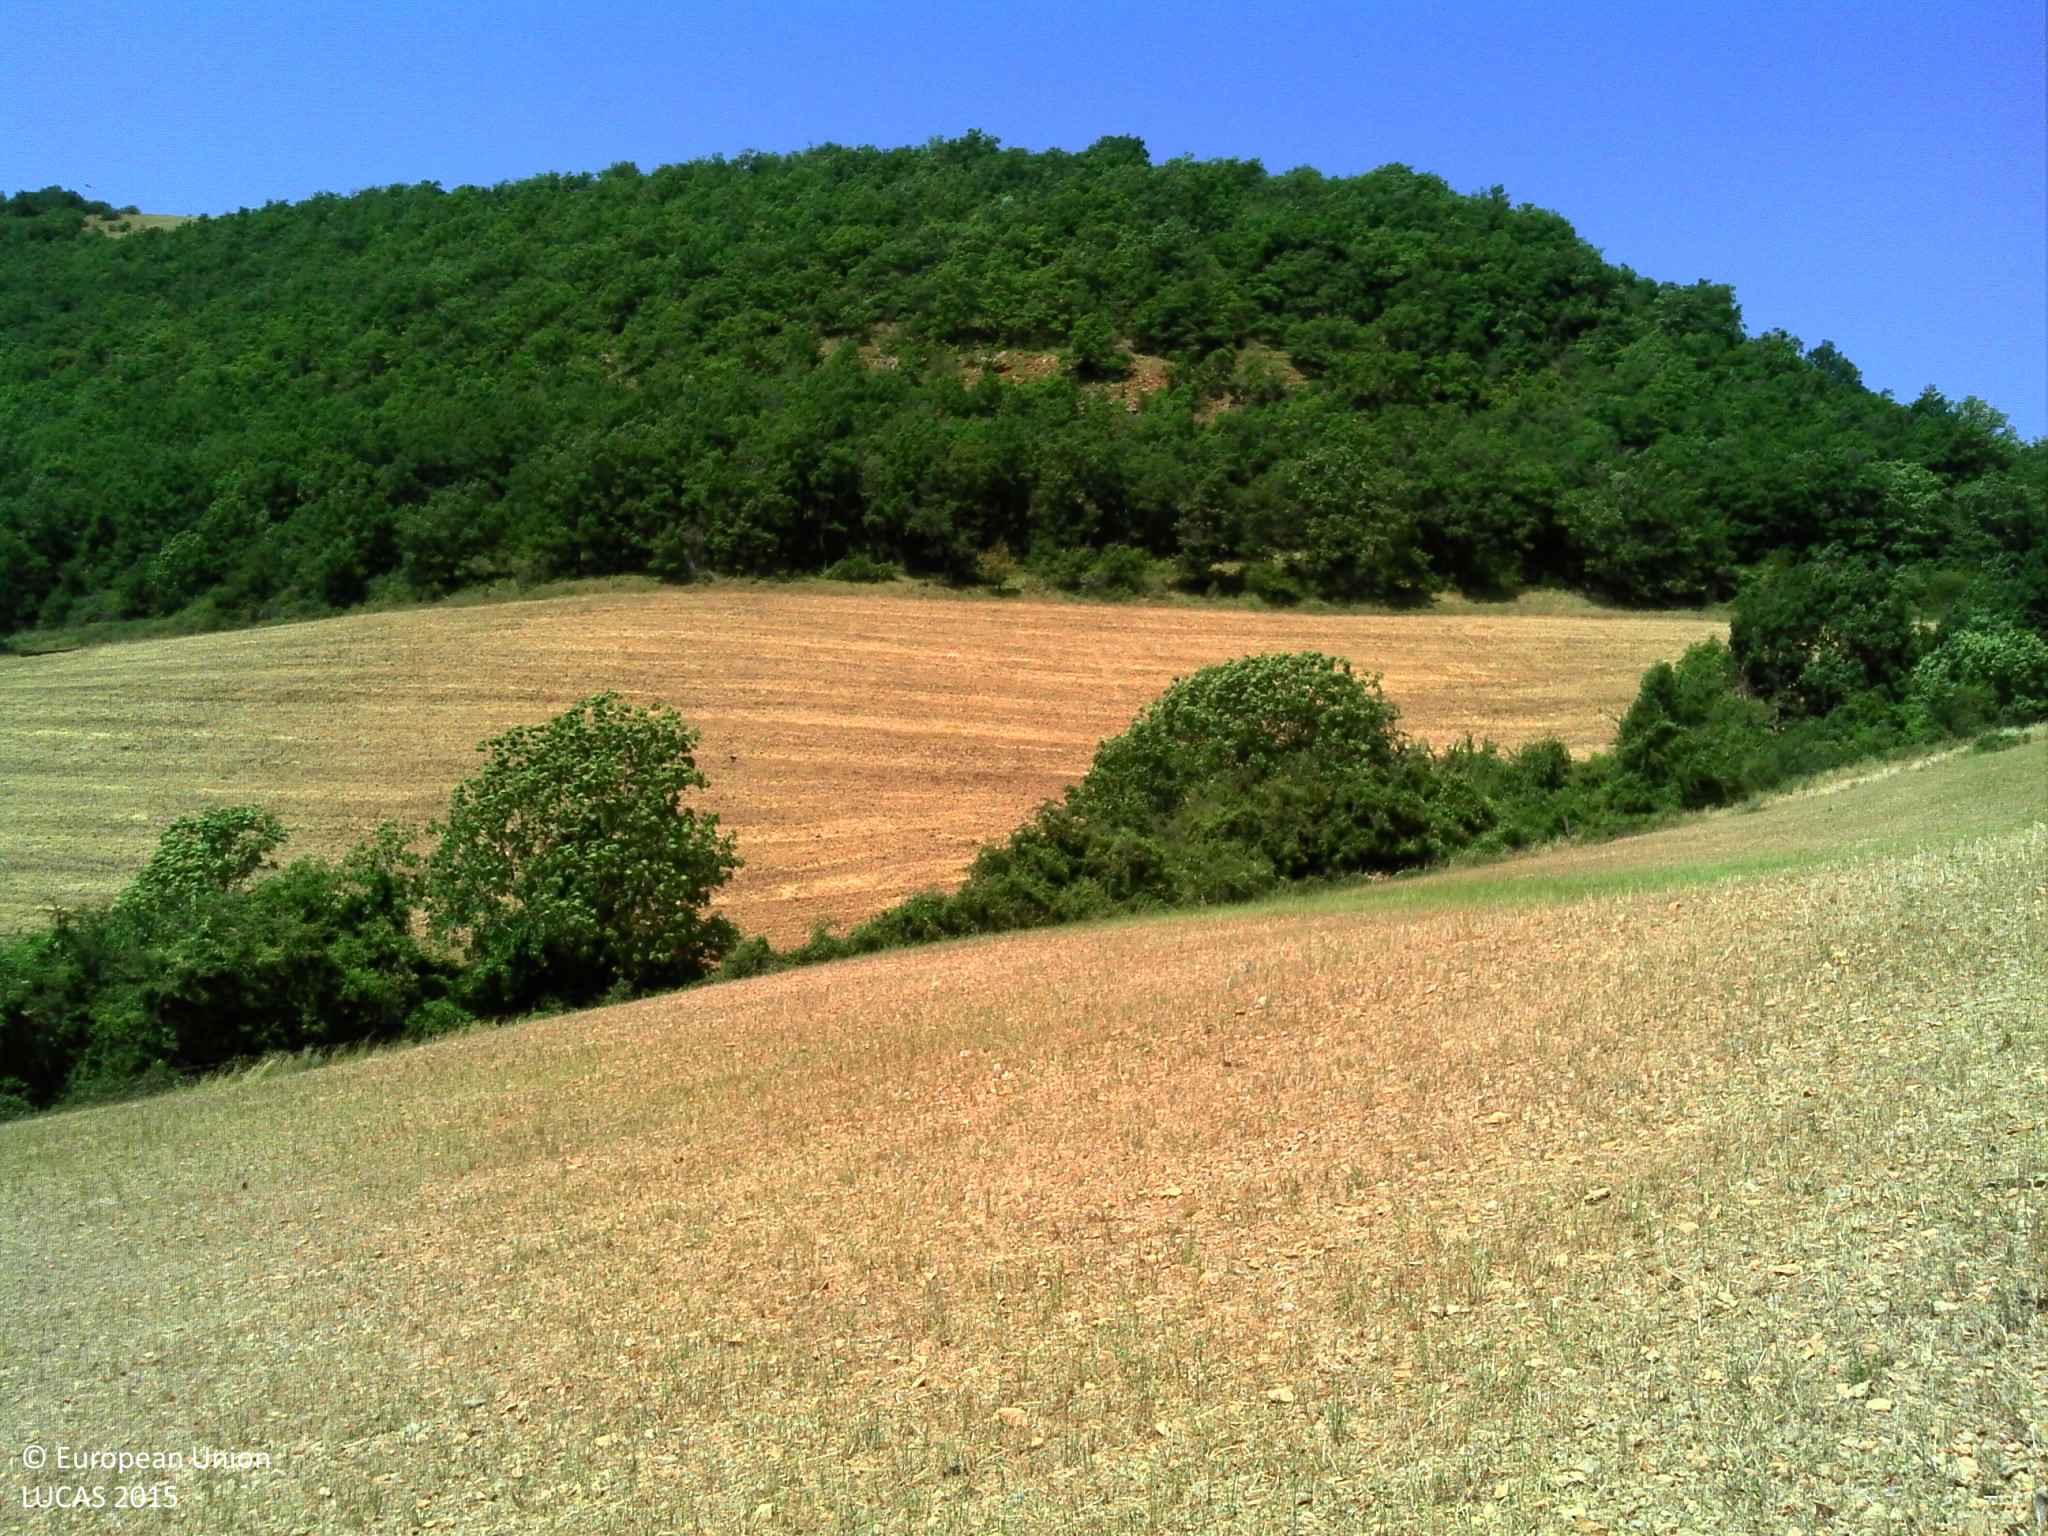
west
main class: Cropland
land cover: Temporary grasslands
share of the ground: 25 - 50 %
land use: Agriculture (excluding fallow land and kitchen gardens)
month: July
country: FR
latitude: 44.1367
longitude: 3.0684
